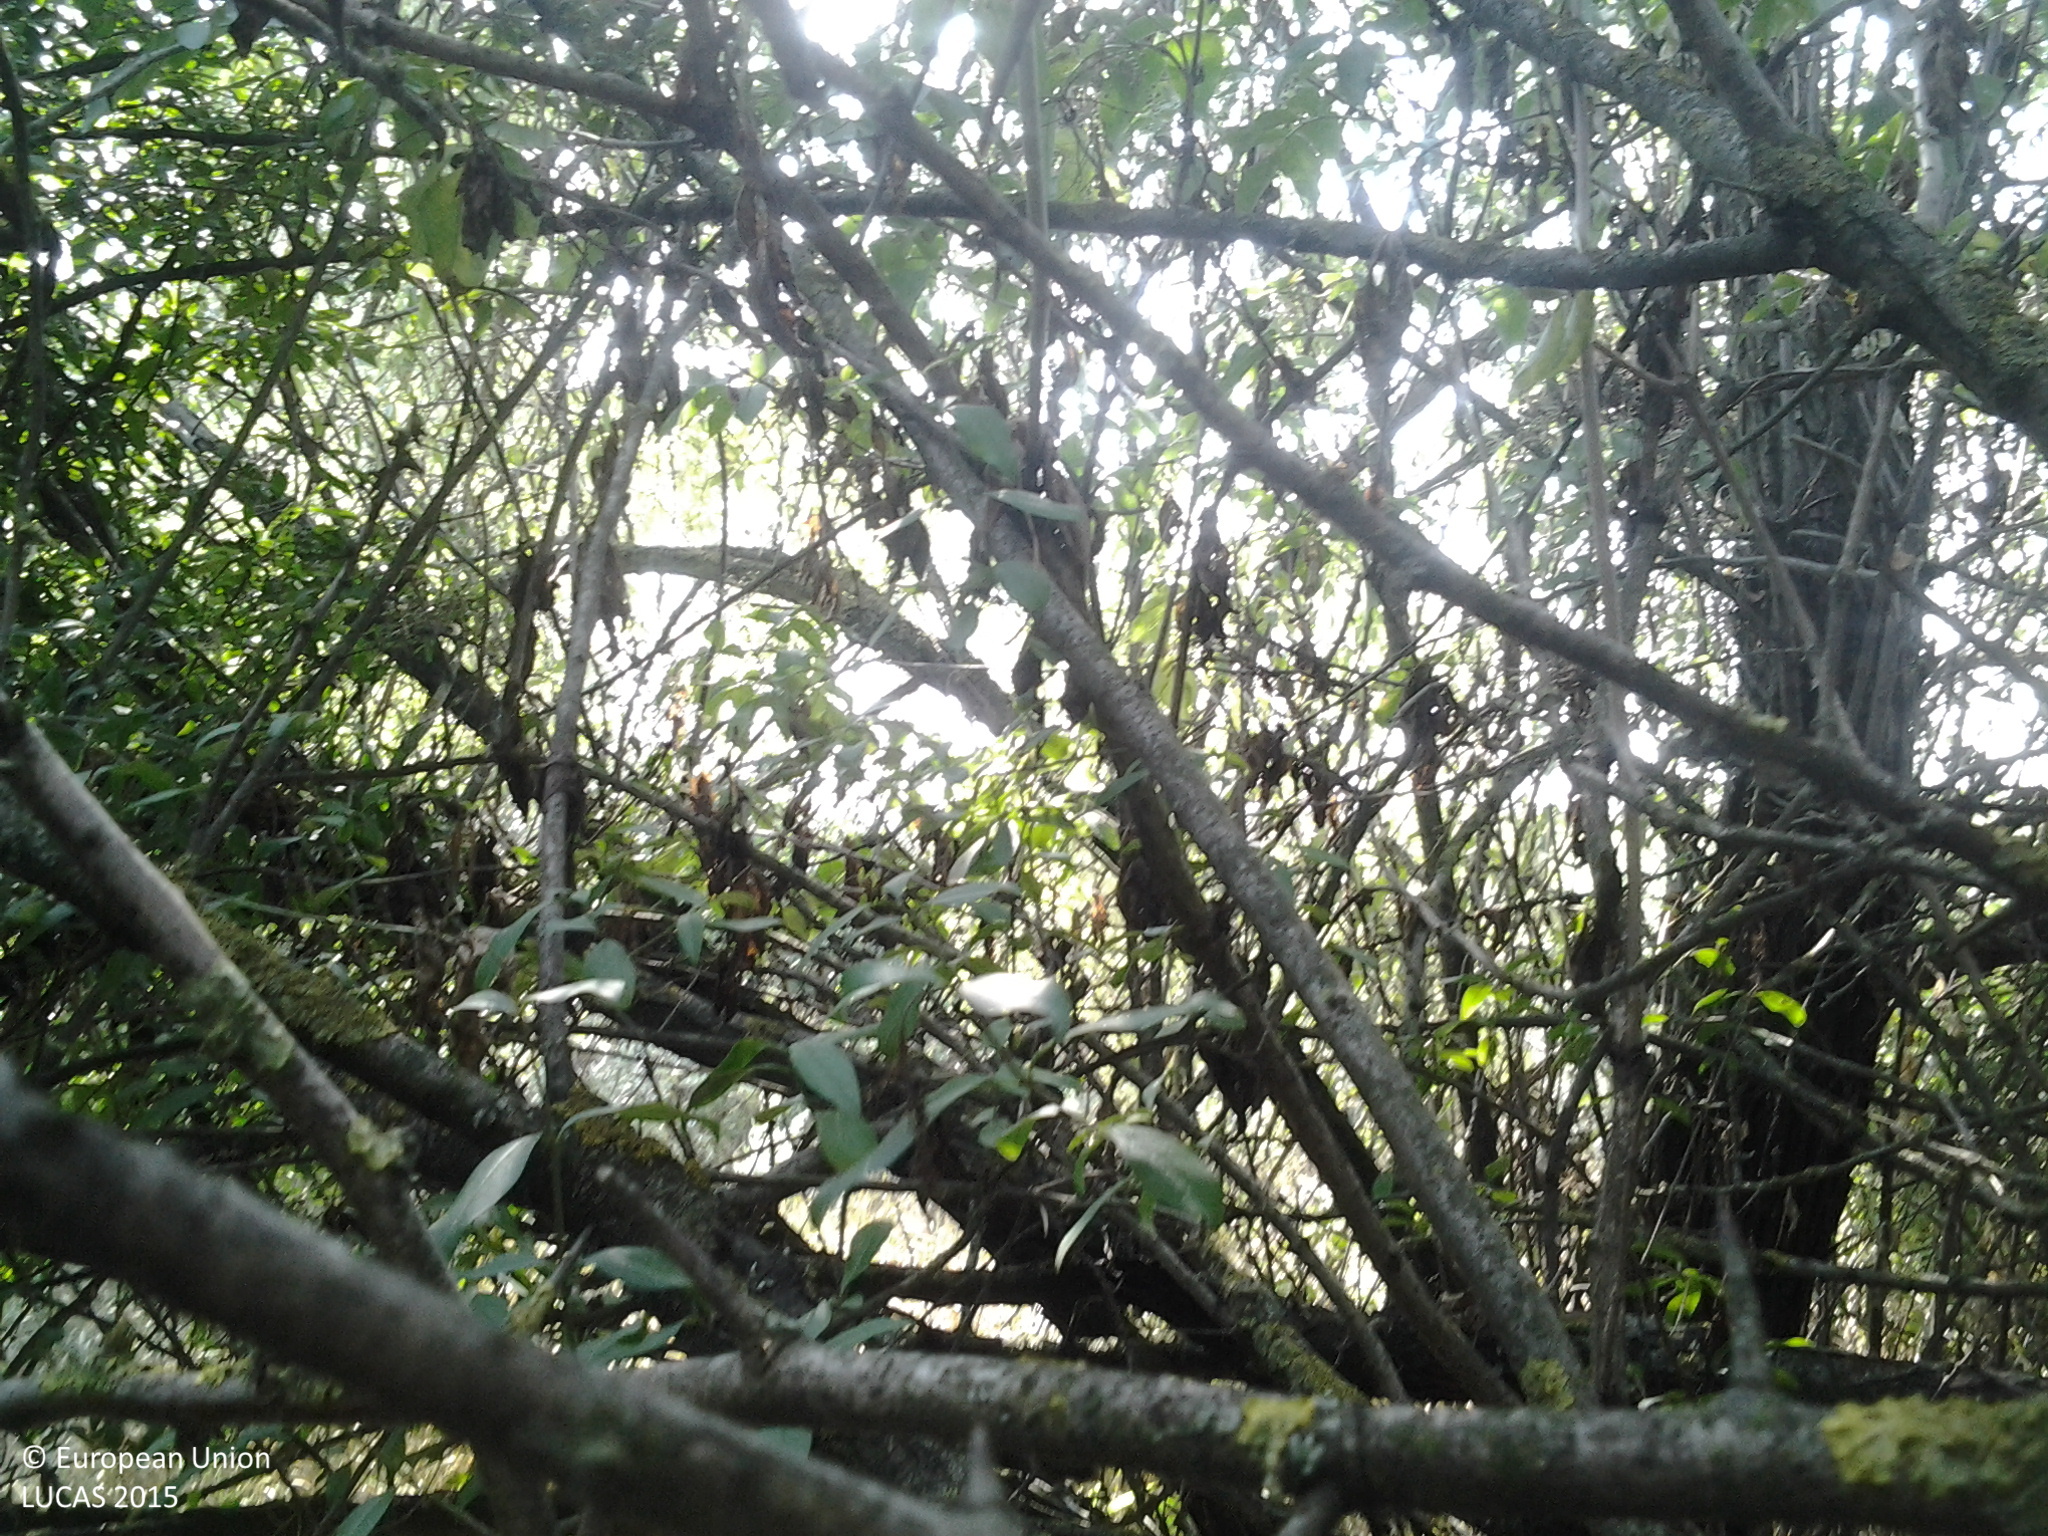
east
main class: Woodland
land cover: Broadleaved woodland
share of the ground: 50 - 75 %
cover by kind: broadleaved forest trees 60 %, herbaceous plants 40 %
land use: Semi-natural and natural areas not in use
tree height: > 5 m
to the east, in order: Broadleaved woodland; Spontaneously vegetated surfaces; Lucerne; Grassland without tree/shrub cover; Tracks; Grassland without tree/shrub cover; Tracks; Grassland without tree/shrub cover
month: July
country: HU
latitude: 46.8032
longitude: 19.2281
